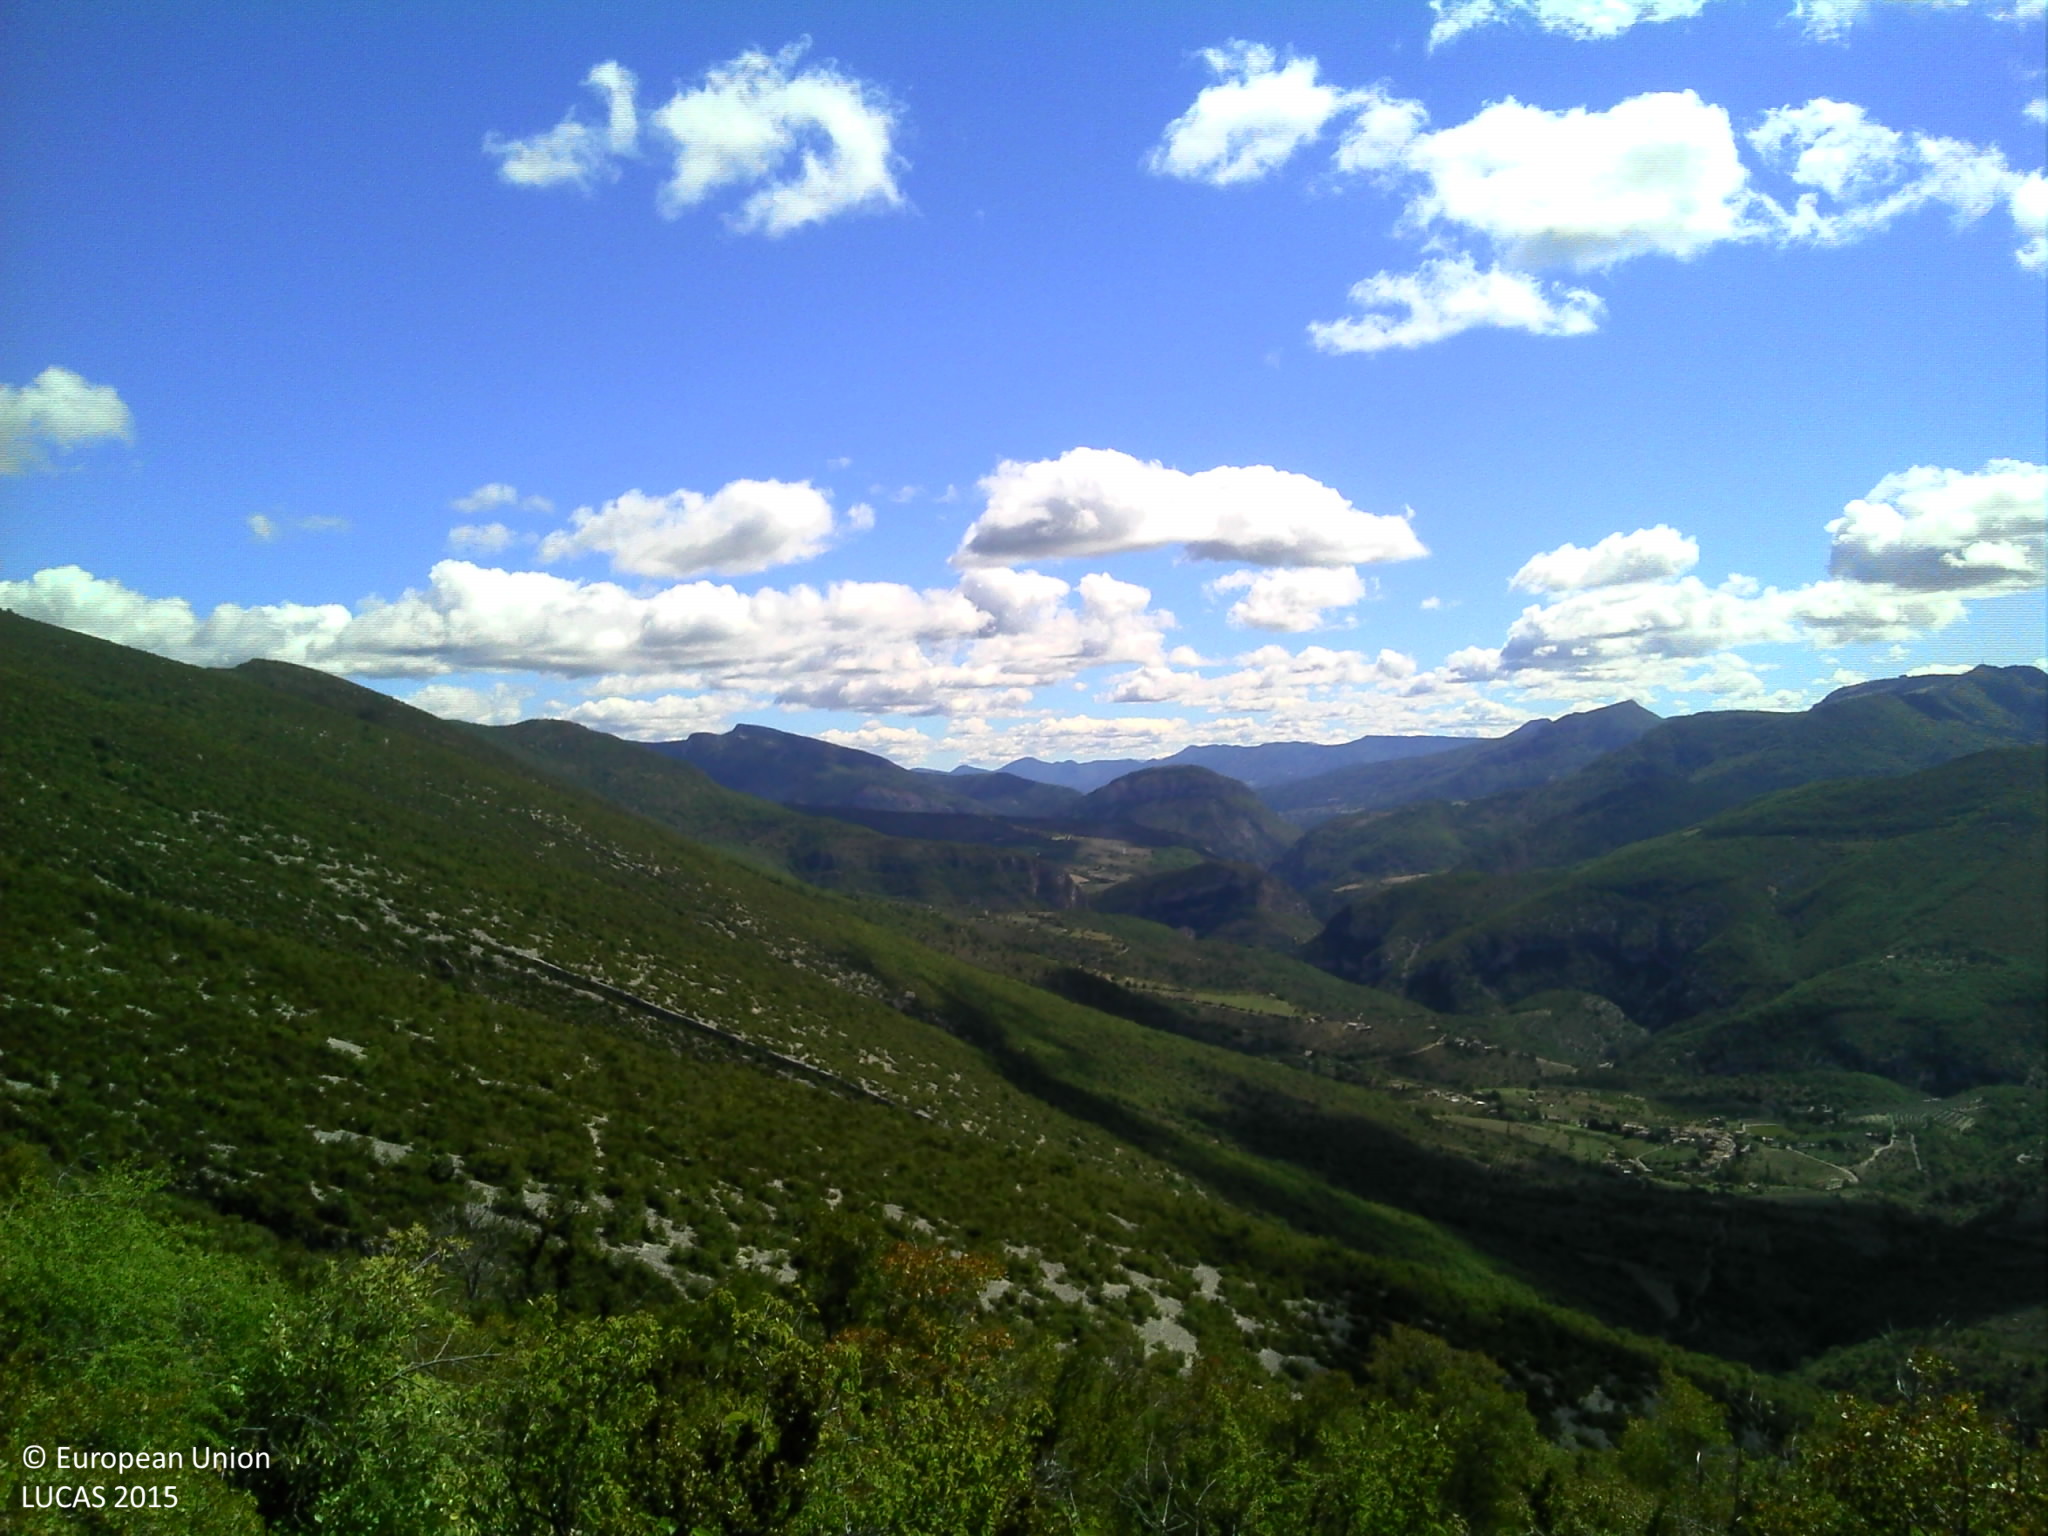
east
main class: Shrubland
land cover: Shrubland without tree cover
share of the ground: > 75 %
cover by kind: shrubs 90 %, unconsolidated bare surface 10 %
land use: Semi-natural and natural areas not in use
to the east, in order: Shrubland without tree cover; Other bare soil; Shrubland without tree cover; Other bare soil; Shrubland without tree cover; Other bare soil; Shrubland with sparse tree cover; Shrubland without tree cover
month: September
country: FR
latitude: 44.4594
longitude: 5.2689
